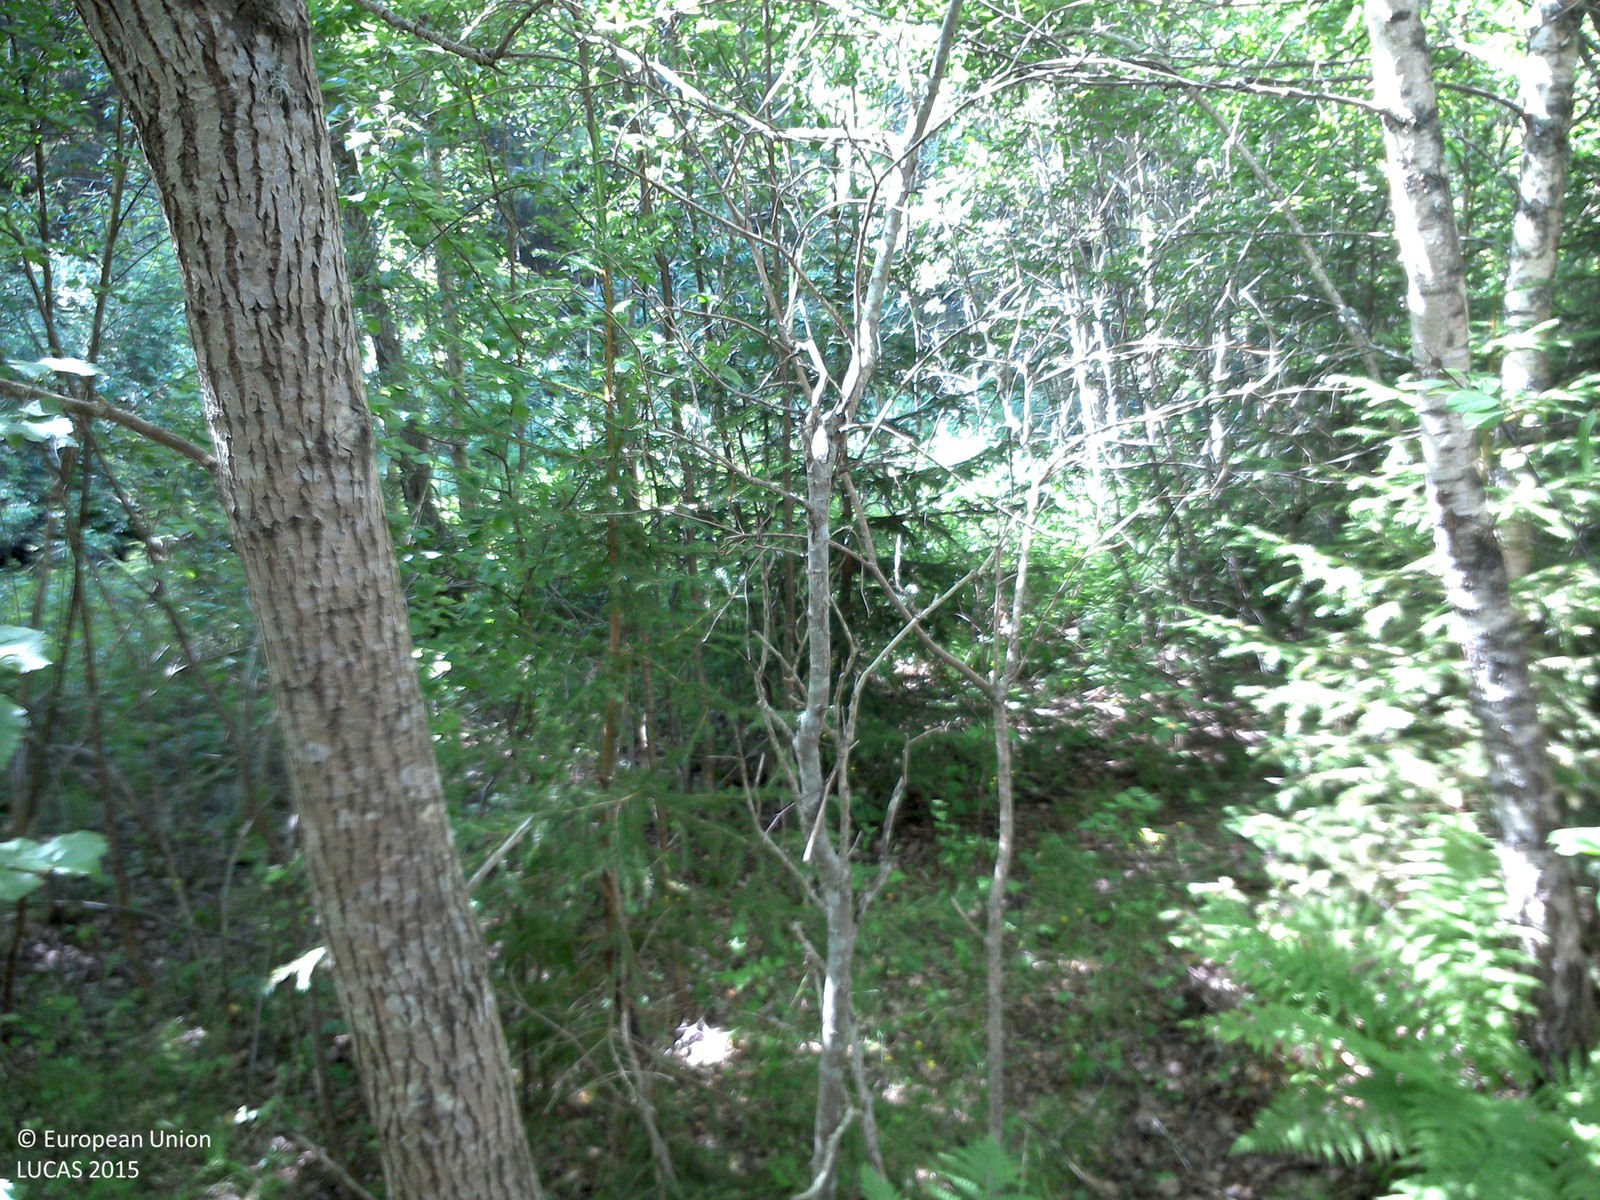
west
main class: Woodland
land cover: Broadleaved woodland
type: boreal forest
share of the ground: > 75 %
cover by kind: broadleaved forest trees 80 %, herbaceous plants 20 %
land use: Forestry
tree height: > 5 m
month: July
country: SE
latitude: 58.1039
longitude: 14.6268
